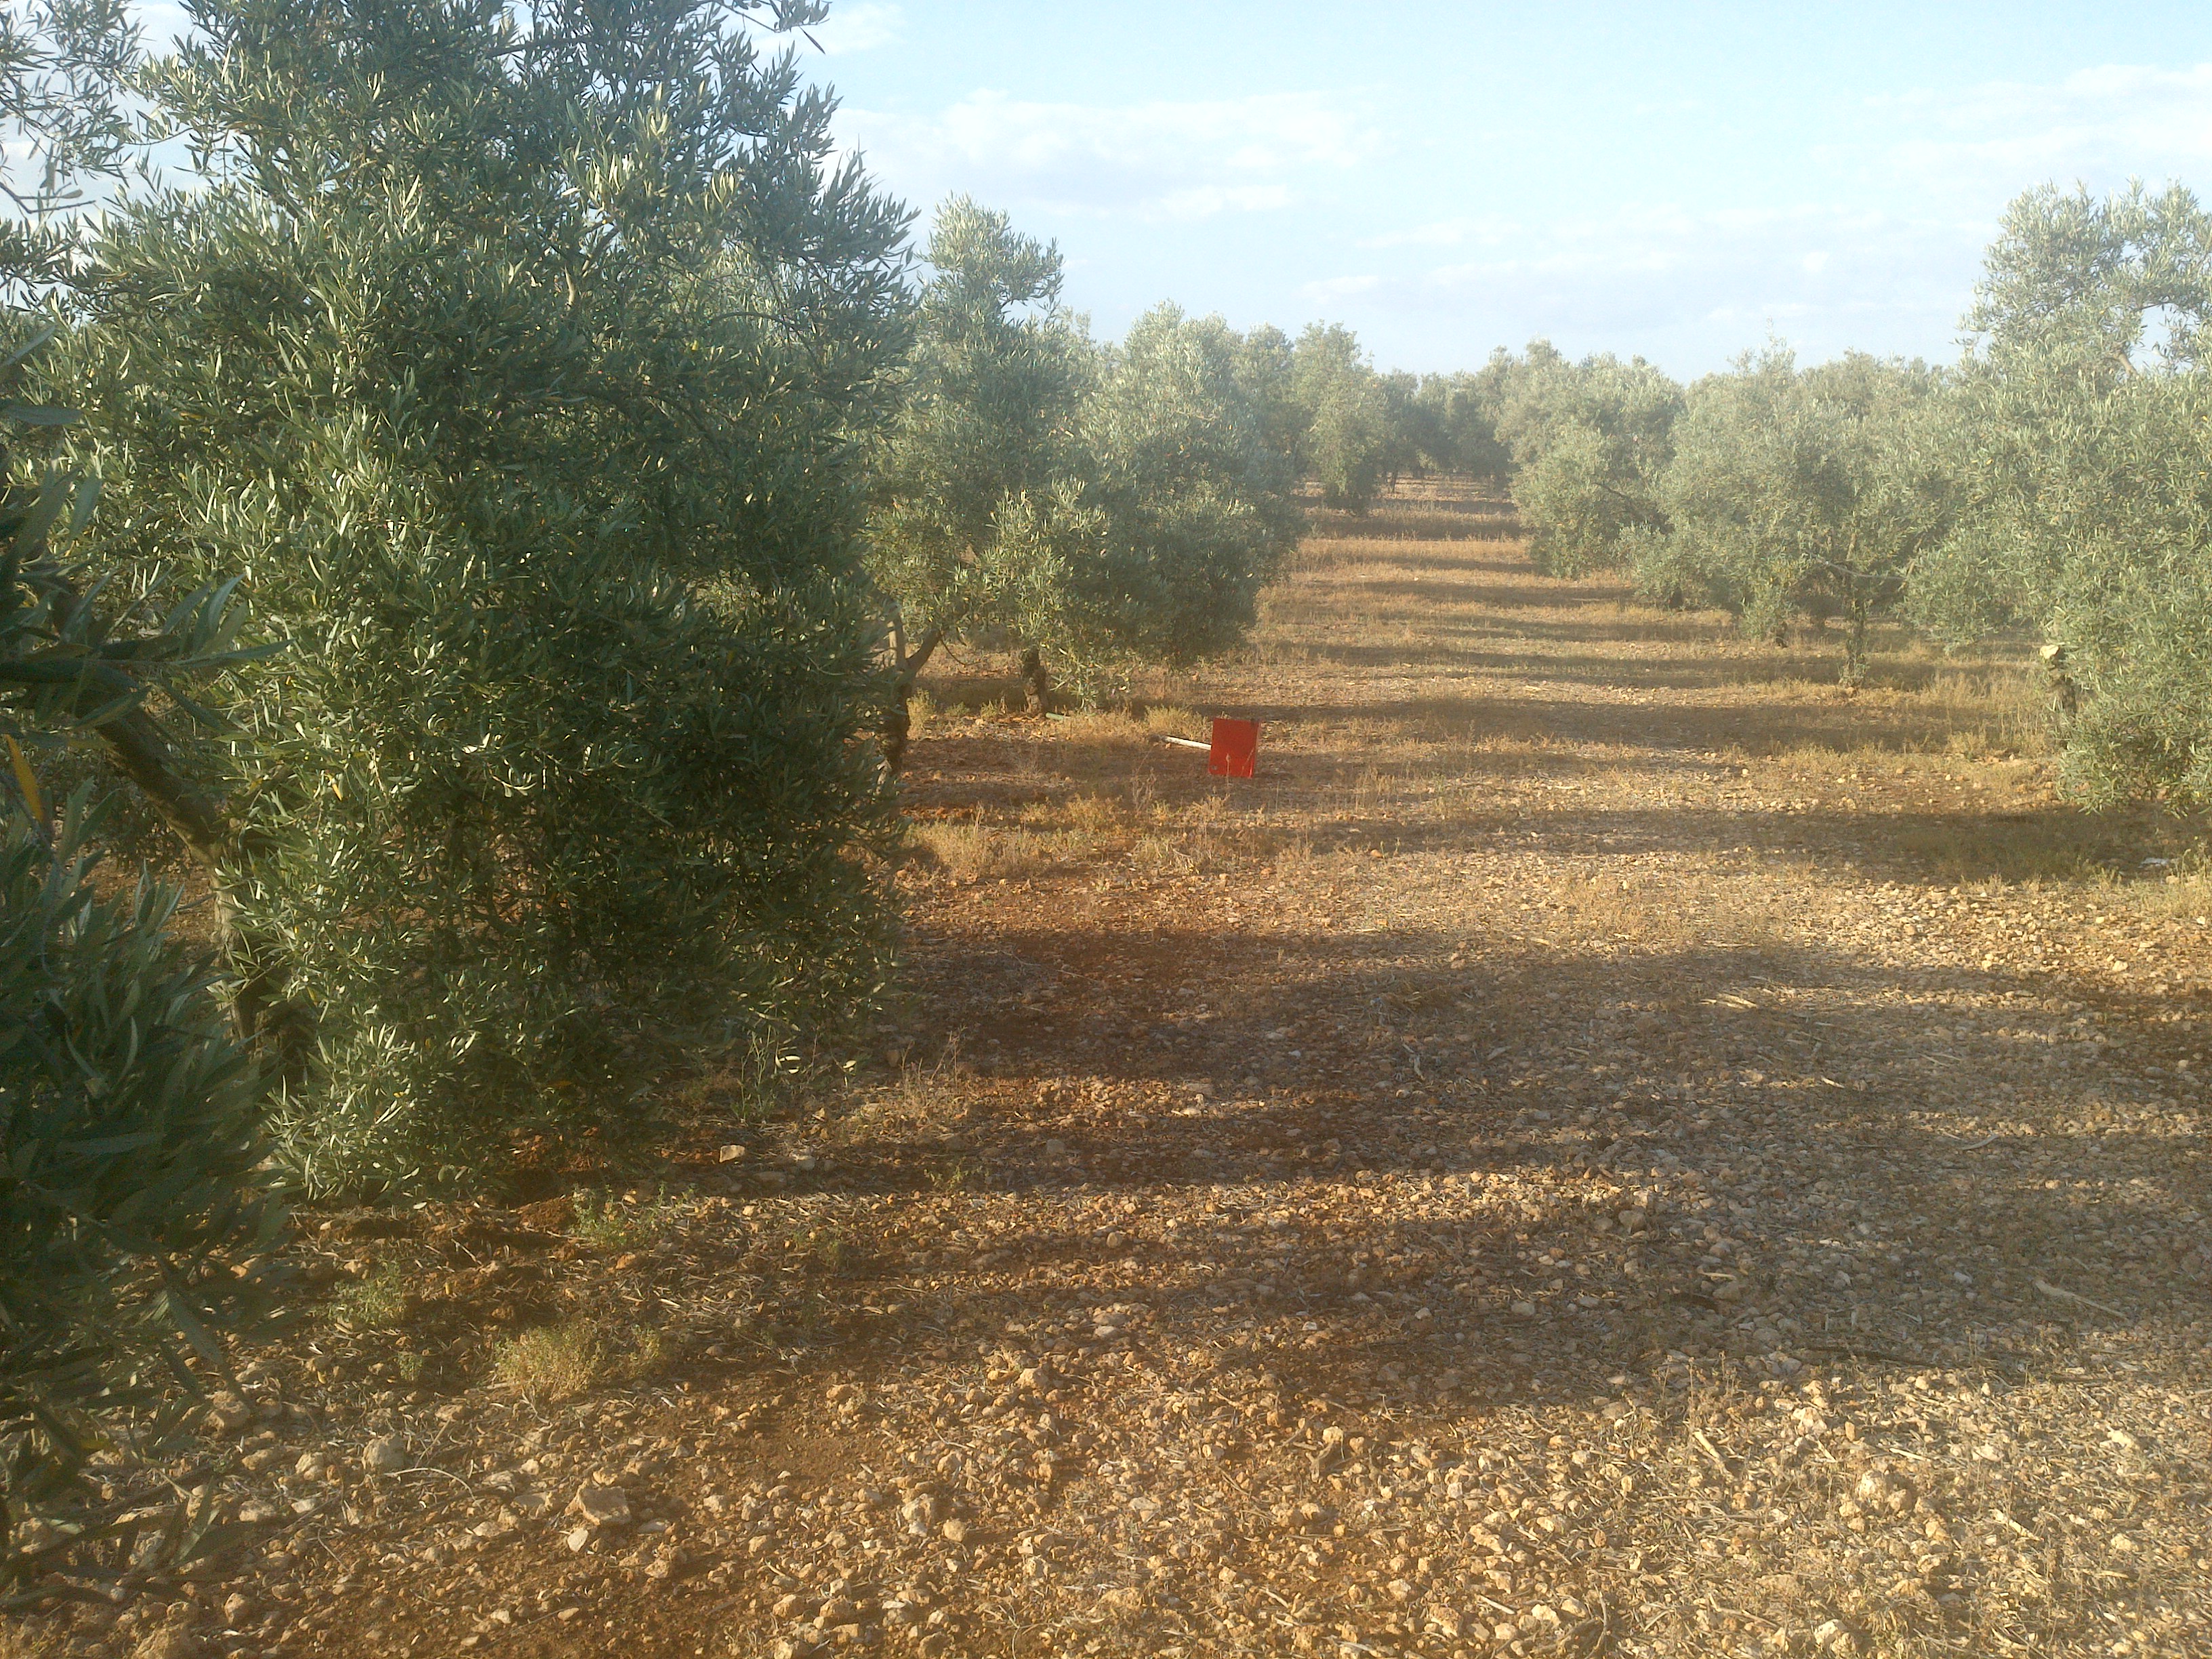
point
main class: Cropland
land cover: Olive groves
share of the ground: 50 - 75 %
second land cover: Other bare soil
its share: > 75 %
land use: Agriculture (excluding fallow land and kitchen gardens)
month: May
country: ES
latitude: 37.3508
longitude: -4.8285
